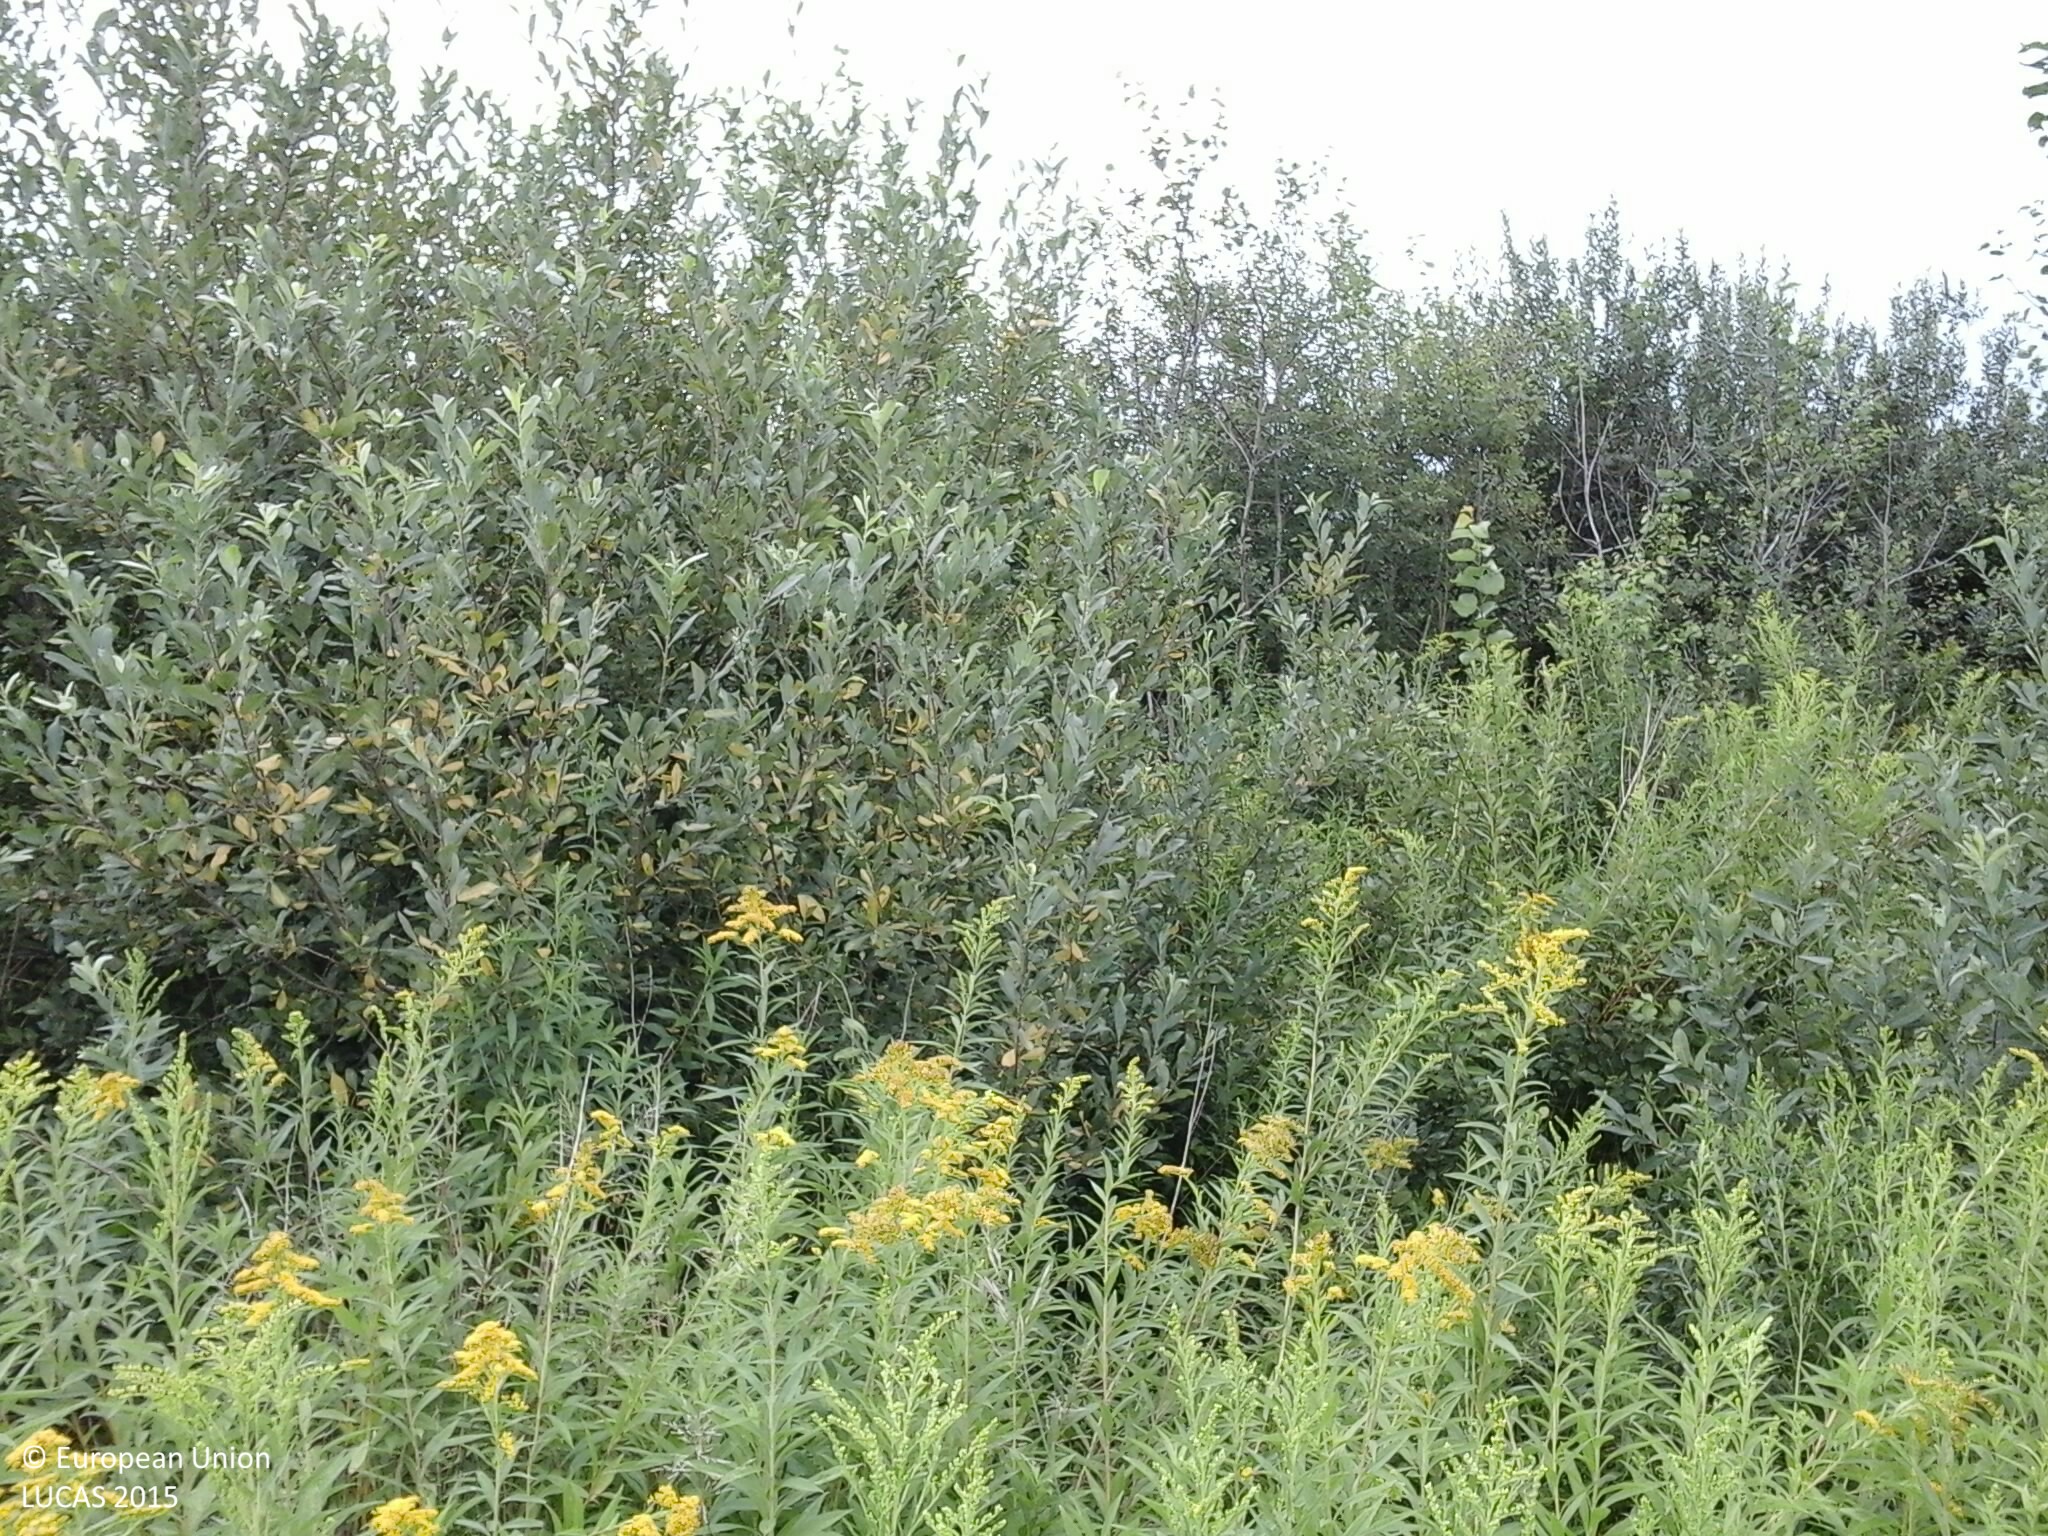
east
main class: Cropland
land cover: Maize
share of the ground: > 75 %
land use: Agriculture (excluding fallow land and kitchen gardens)
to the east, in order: Maize; Shruby margins; Ditches and canals; Grassland without tree/shrub cover; Spontaneously vegetated surfaces
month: July
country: HU
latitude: 46.6463
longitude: 16.4164
